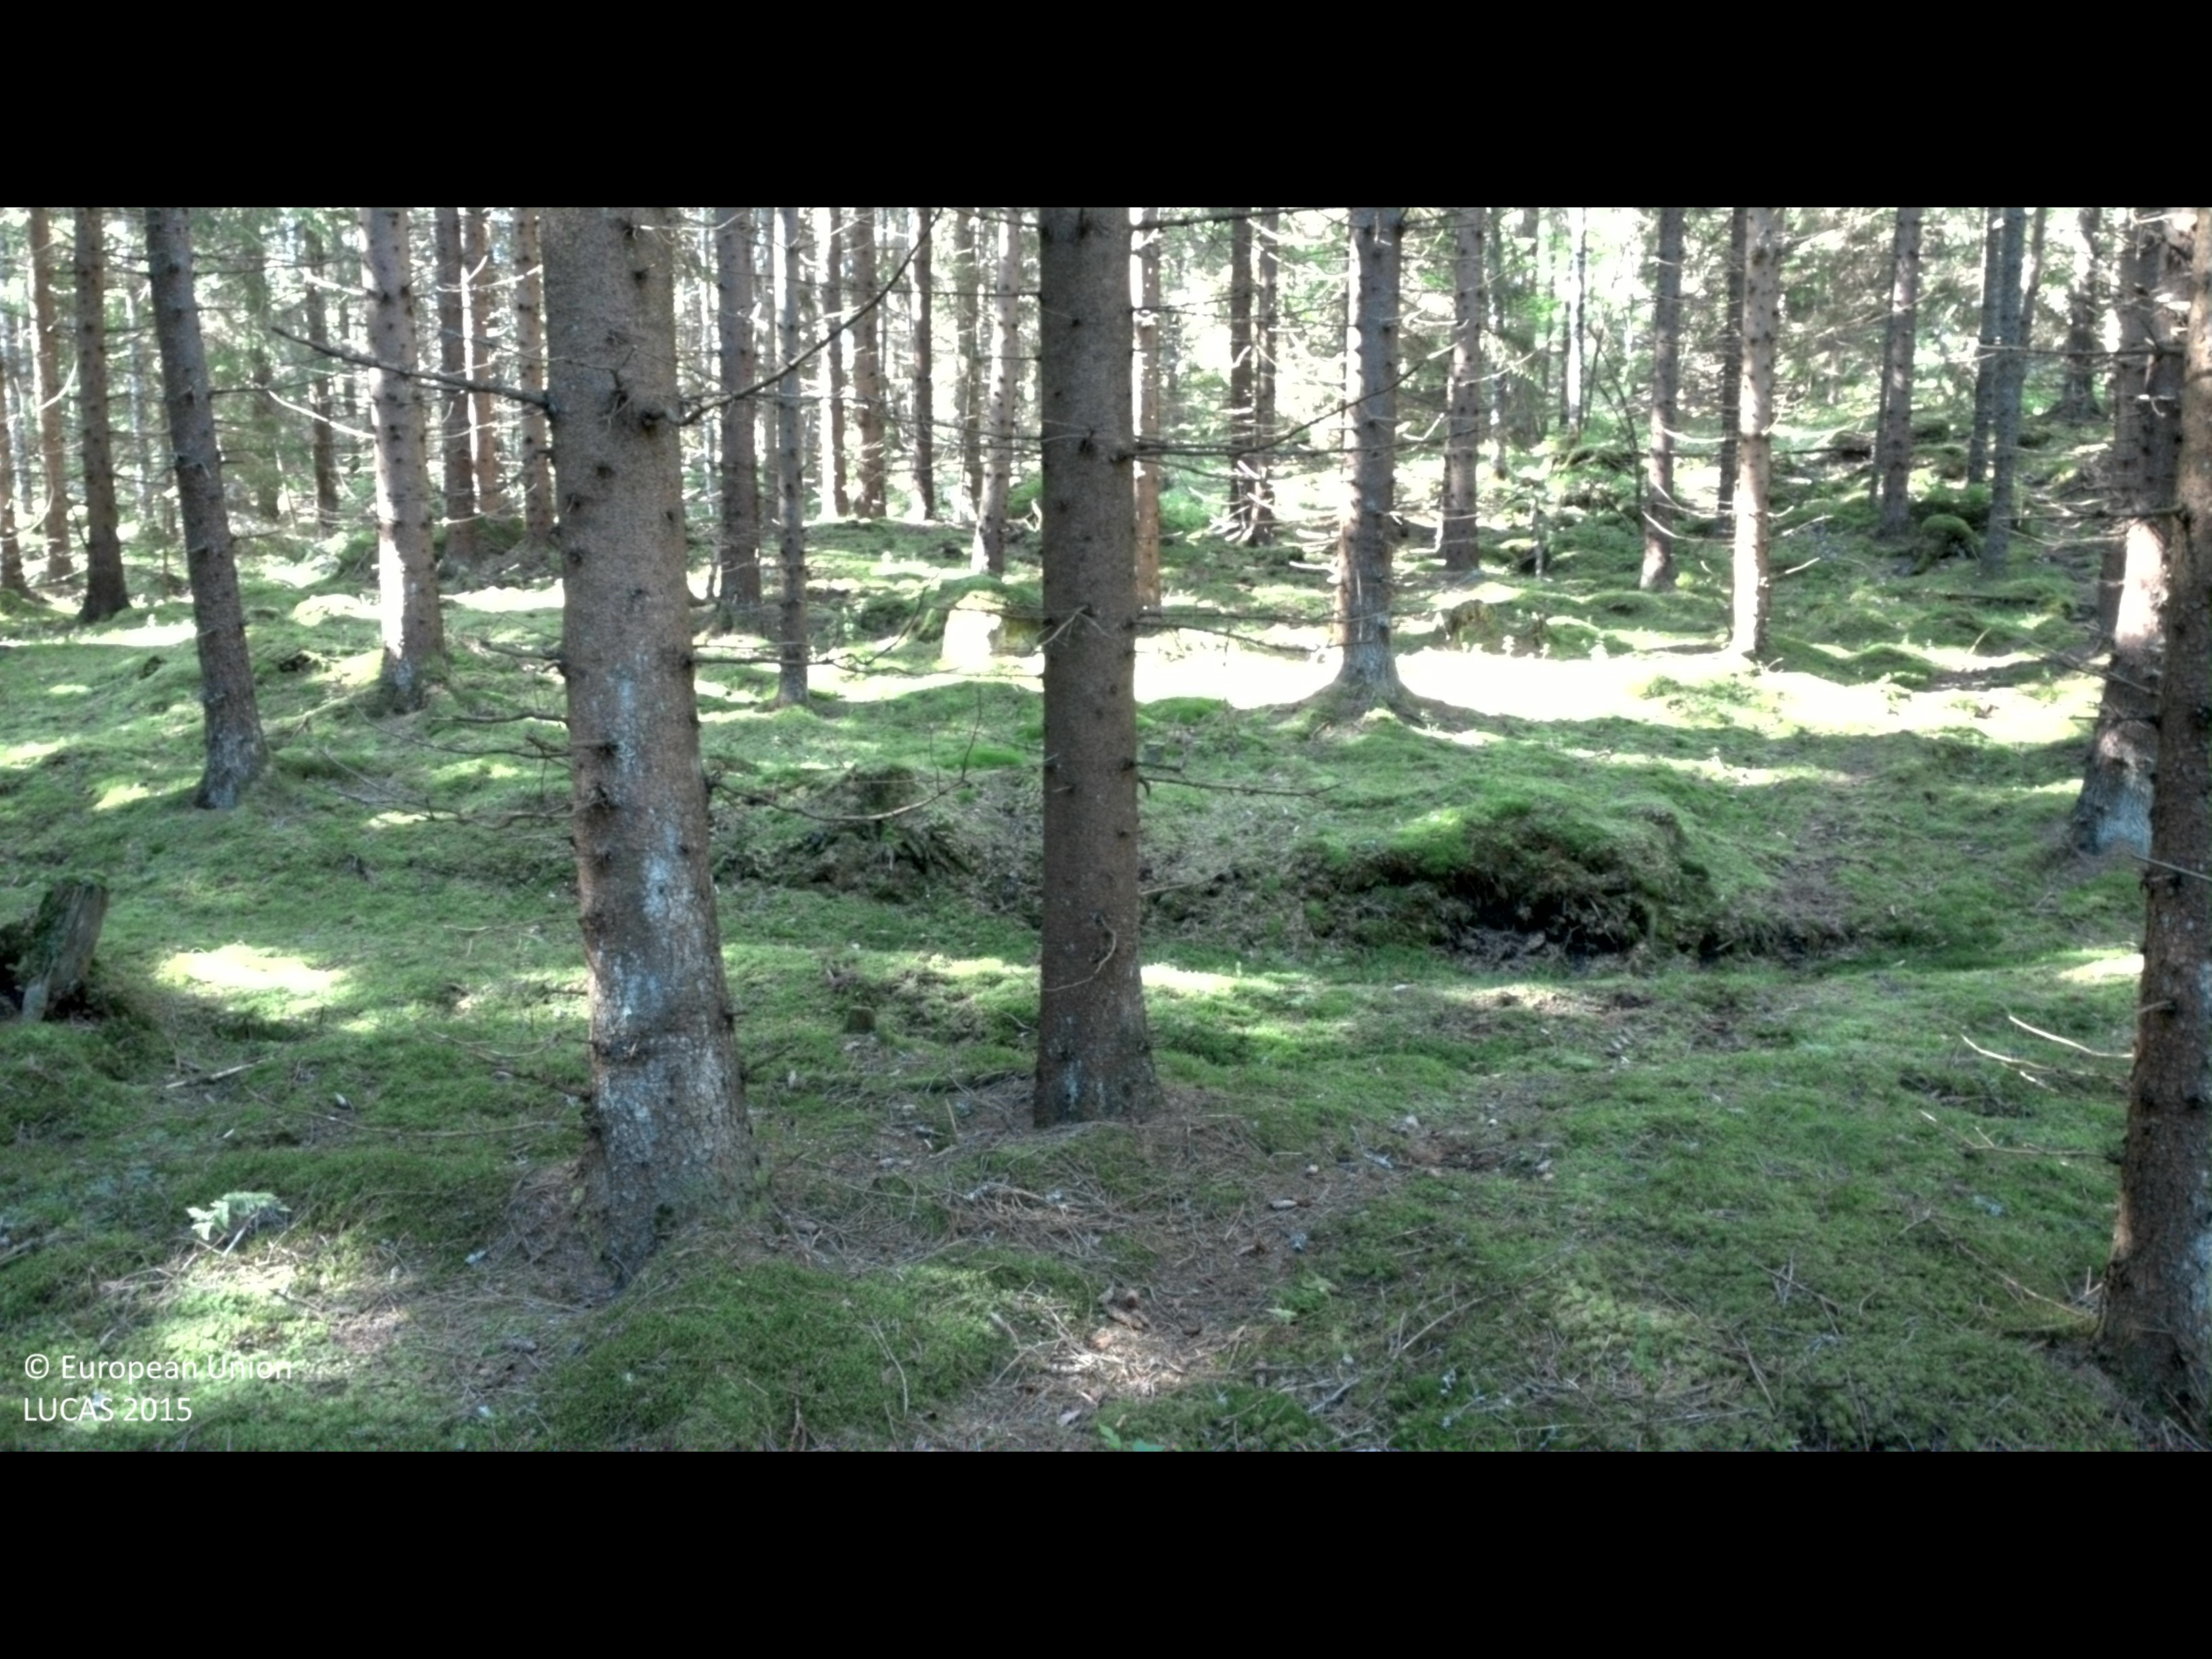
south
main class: Woodland
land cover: Spruce dominated coniferous woodland
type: boreal forest
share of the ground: > 75 %
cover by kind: coniferous forest trees 85 %, lichens and mosses 10 %, shrubs 5 %
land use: Forestry
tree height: > 5 m
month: July
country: SE
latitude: 58.2009
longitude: 16.2408
